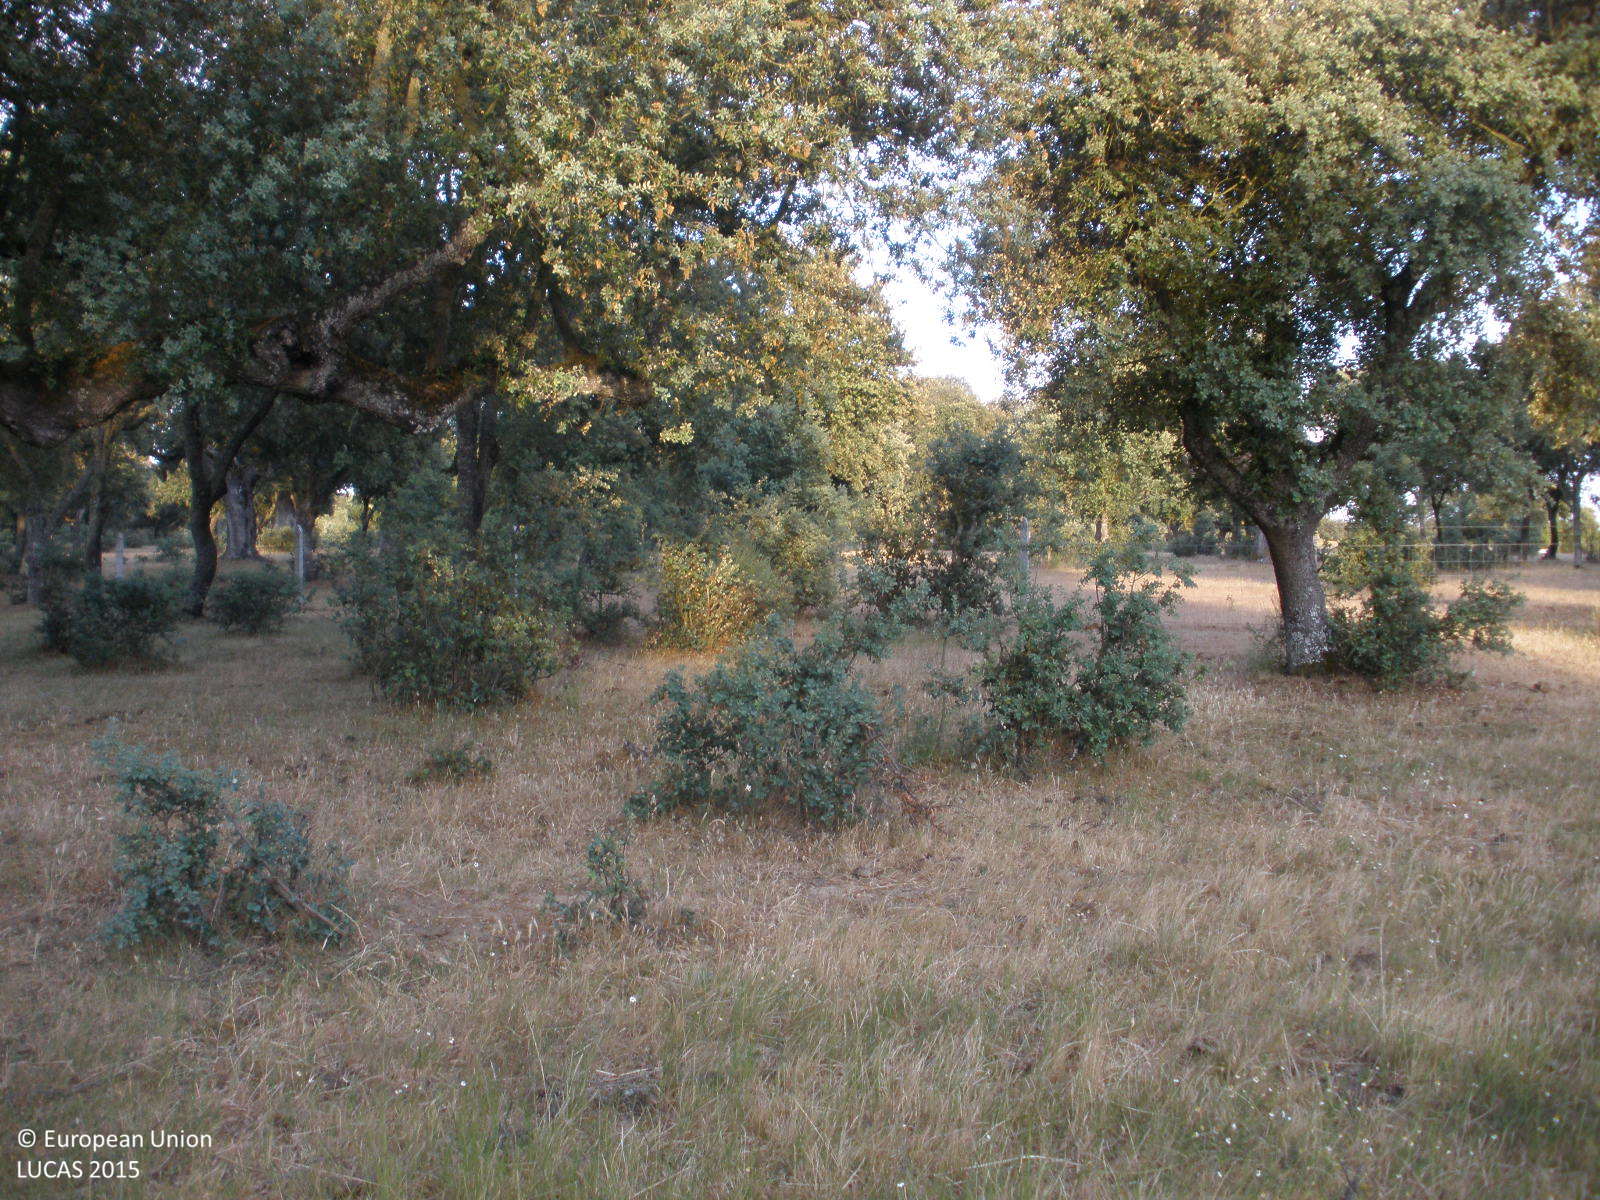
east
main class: Woodland
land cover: Broadleaved woodland
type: broadleaved evergreen forest
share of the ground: 50 - 75 %
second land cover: Grassland without tree/shrub cover
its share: > 75 %
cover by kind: broadleaved forest trees 50 %, herbaceous plants 50 %
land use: Forestry
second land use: Agriculture (excluding fallow land and kitchen gardens)
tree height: > 5 m
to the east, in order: Broadleaved woodland; Grassland without tree/shrub cover; Fences; Broadleaved woodland
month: June
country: ES
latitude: 40.6253
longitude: -6.7278
